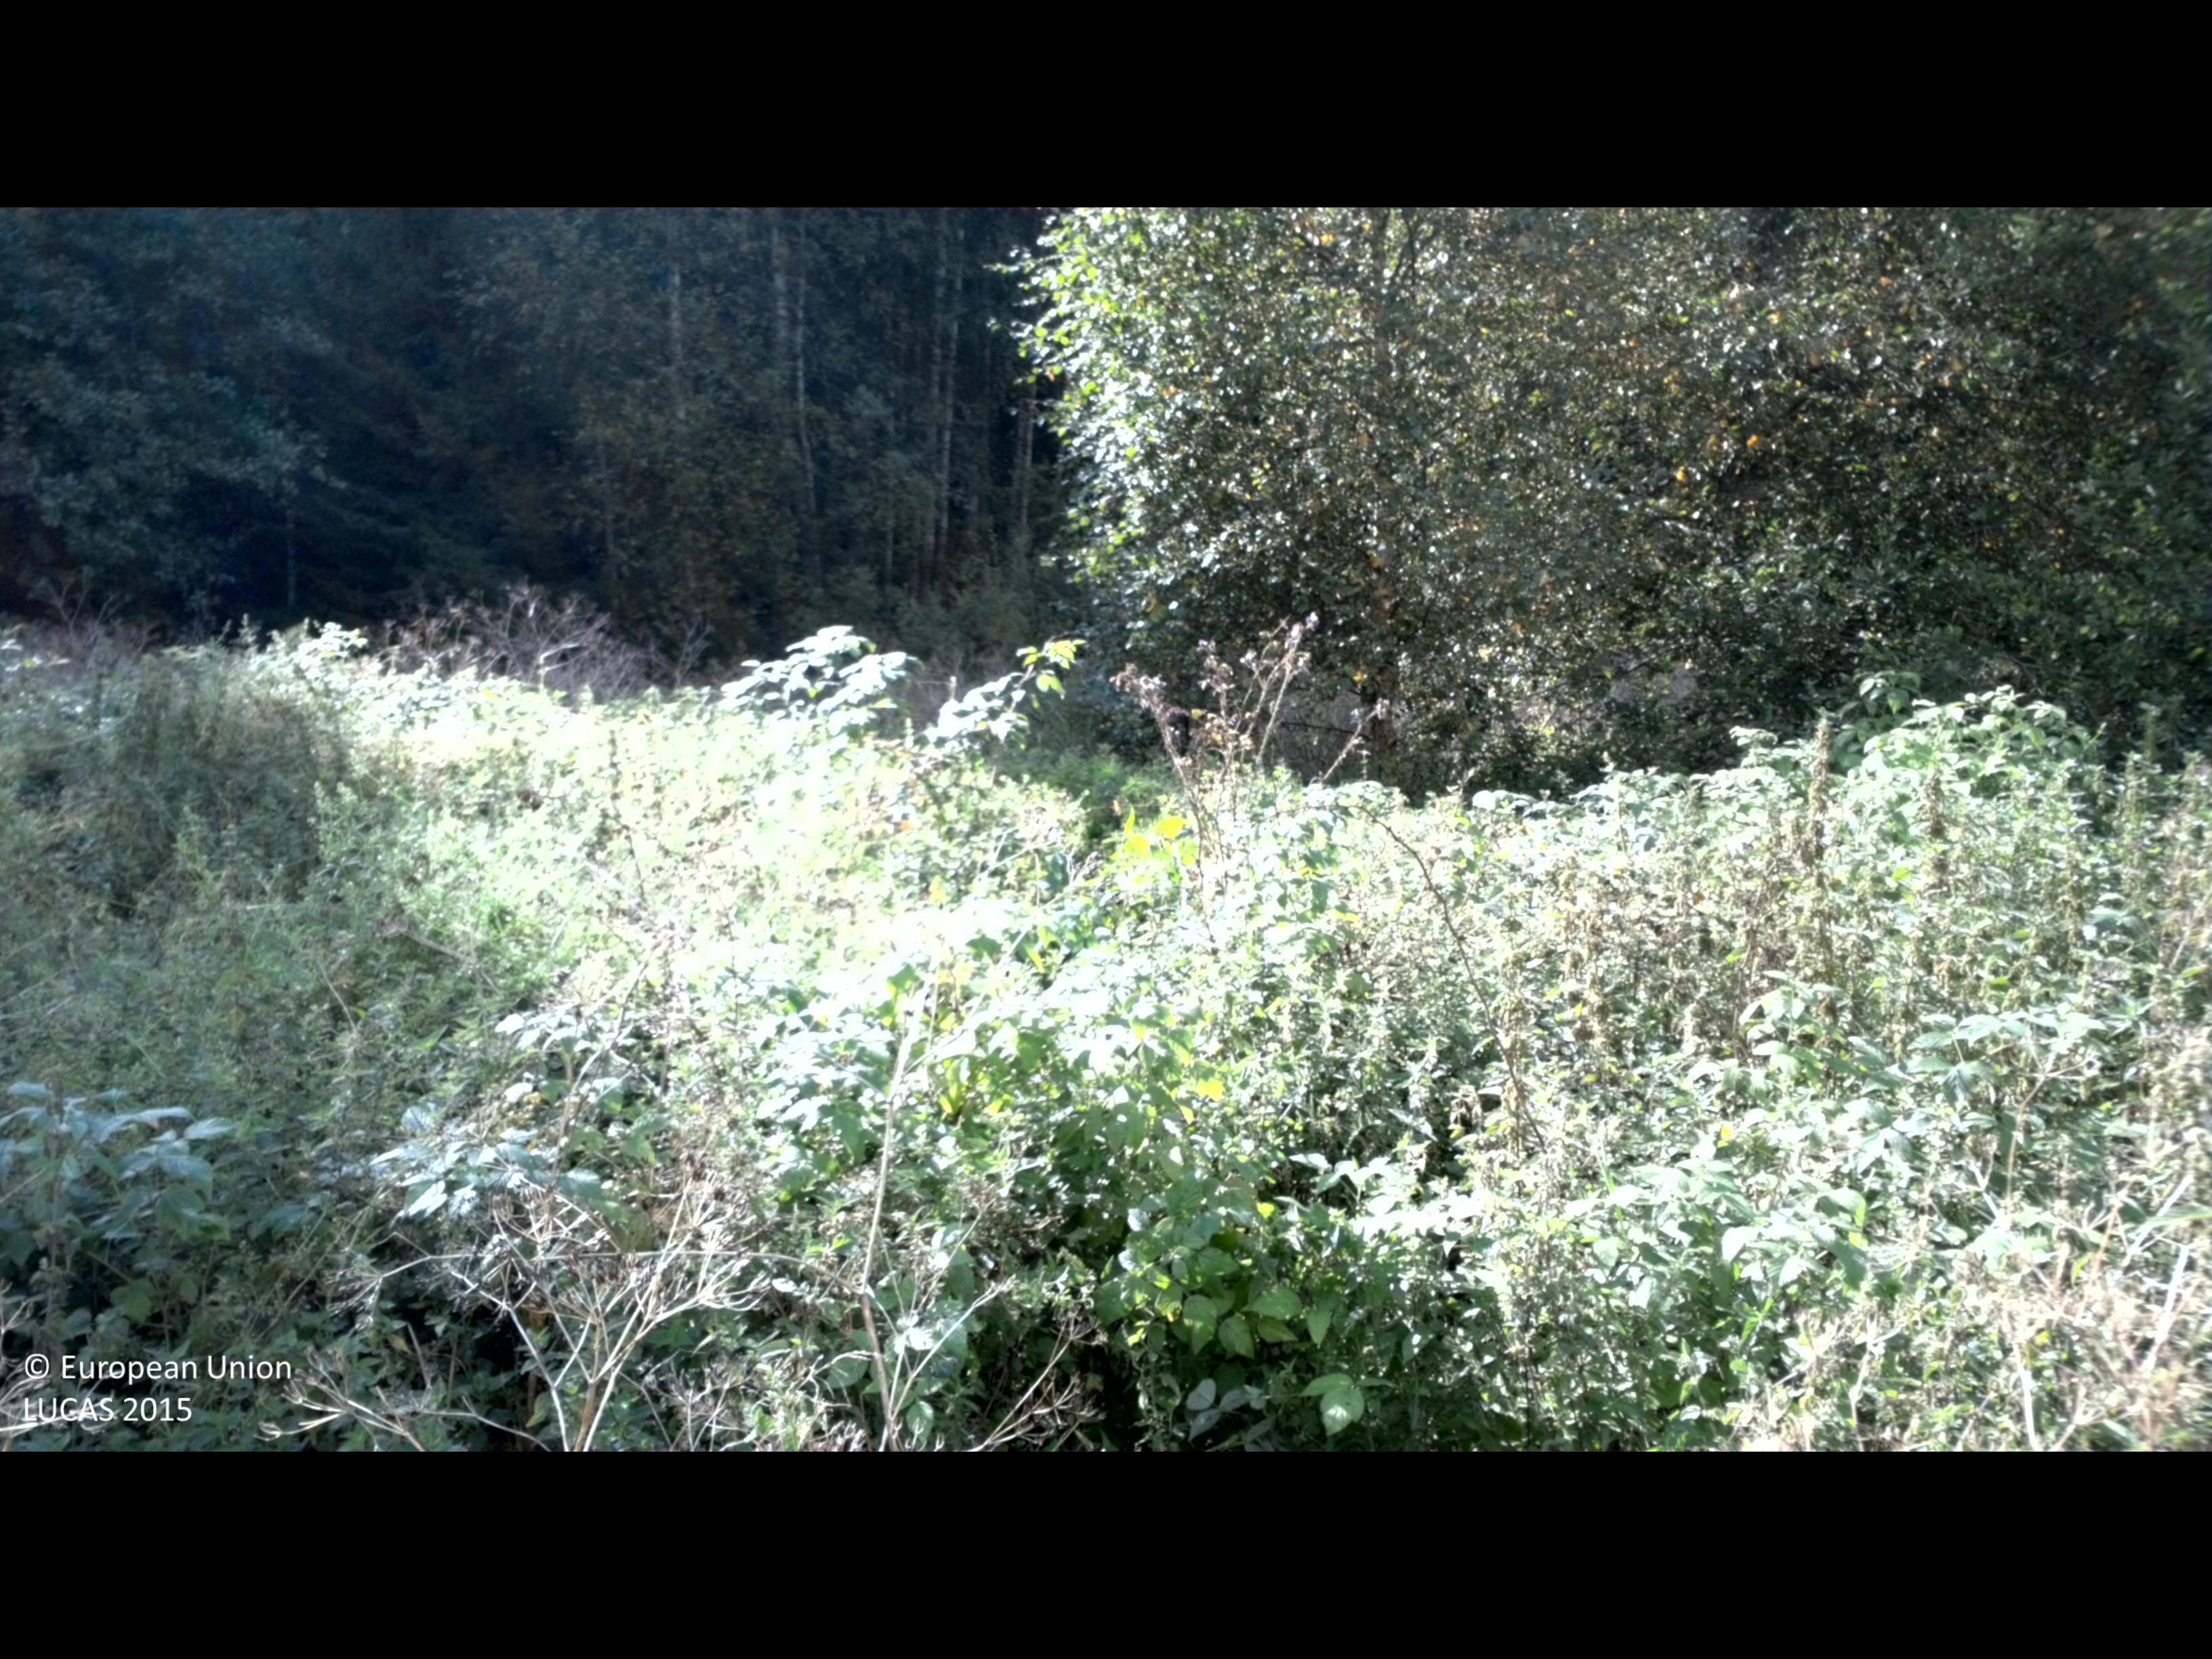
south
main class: Grassland
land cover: Spontaneously vegetated surfaces
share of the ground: > 75 %
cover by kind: herbaceous plants 100 %
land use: Fallow land
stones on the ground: < 10 %
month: September
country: SE
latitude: 56.1778
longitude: 14.5892
